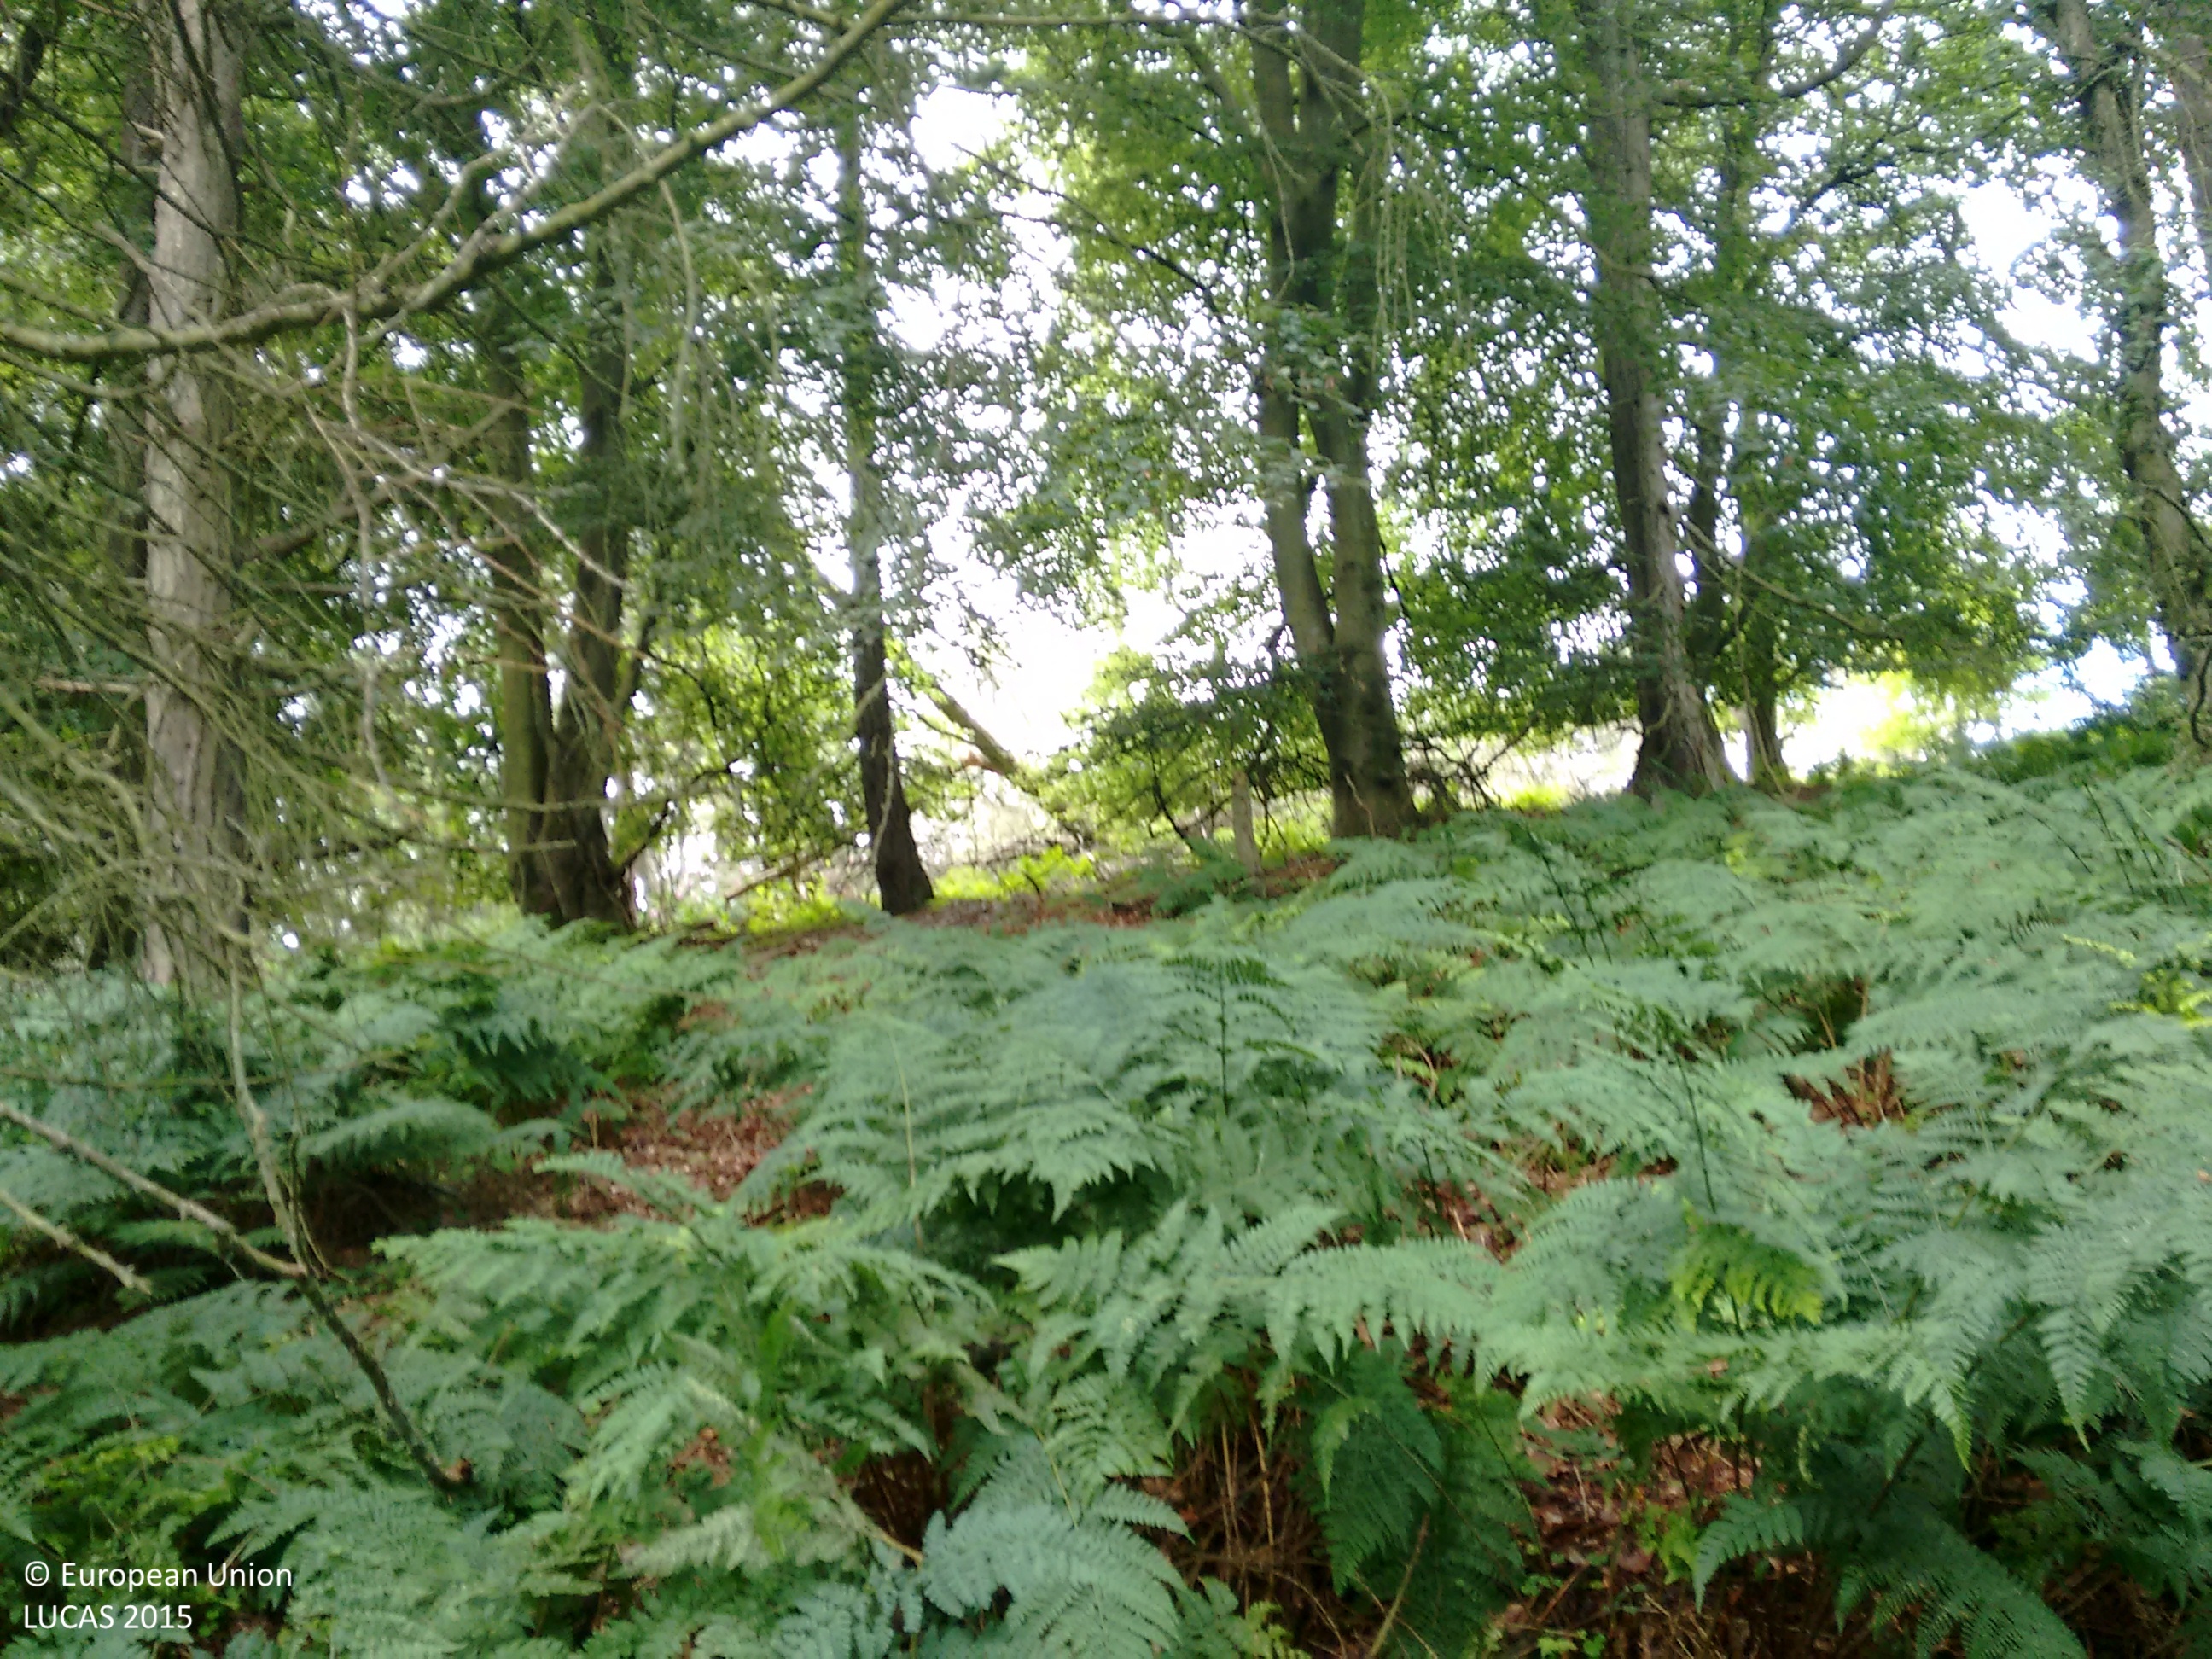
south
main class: Woodland
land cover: Other mixed woodland
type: acidophilous oak and oak-birch forest
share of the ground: > 75 %
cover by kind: coniferous forest trees 60 %, broadleaved forest trees 35 %, herbaceous plants 5 %
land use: Forestry
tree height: > 5 m
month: July
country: GB
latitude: 56.3860
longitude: -2.9416
